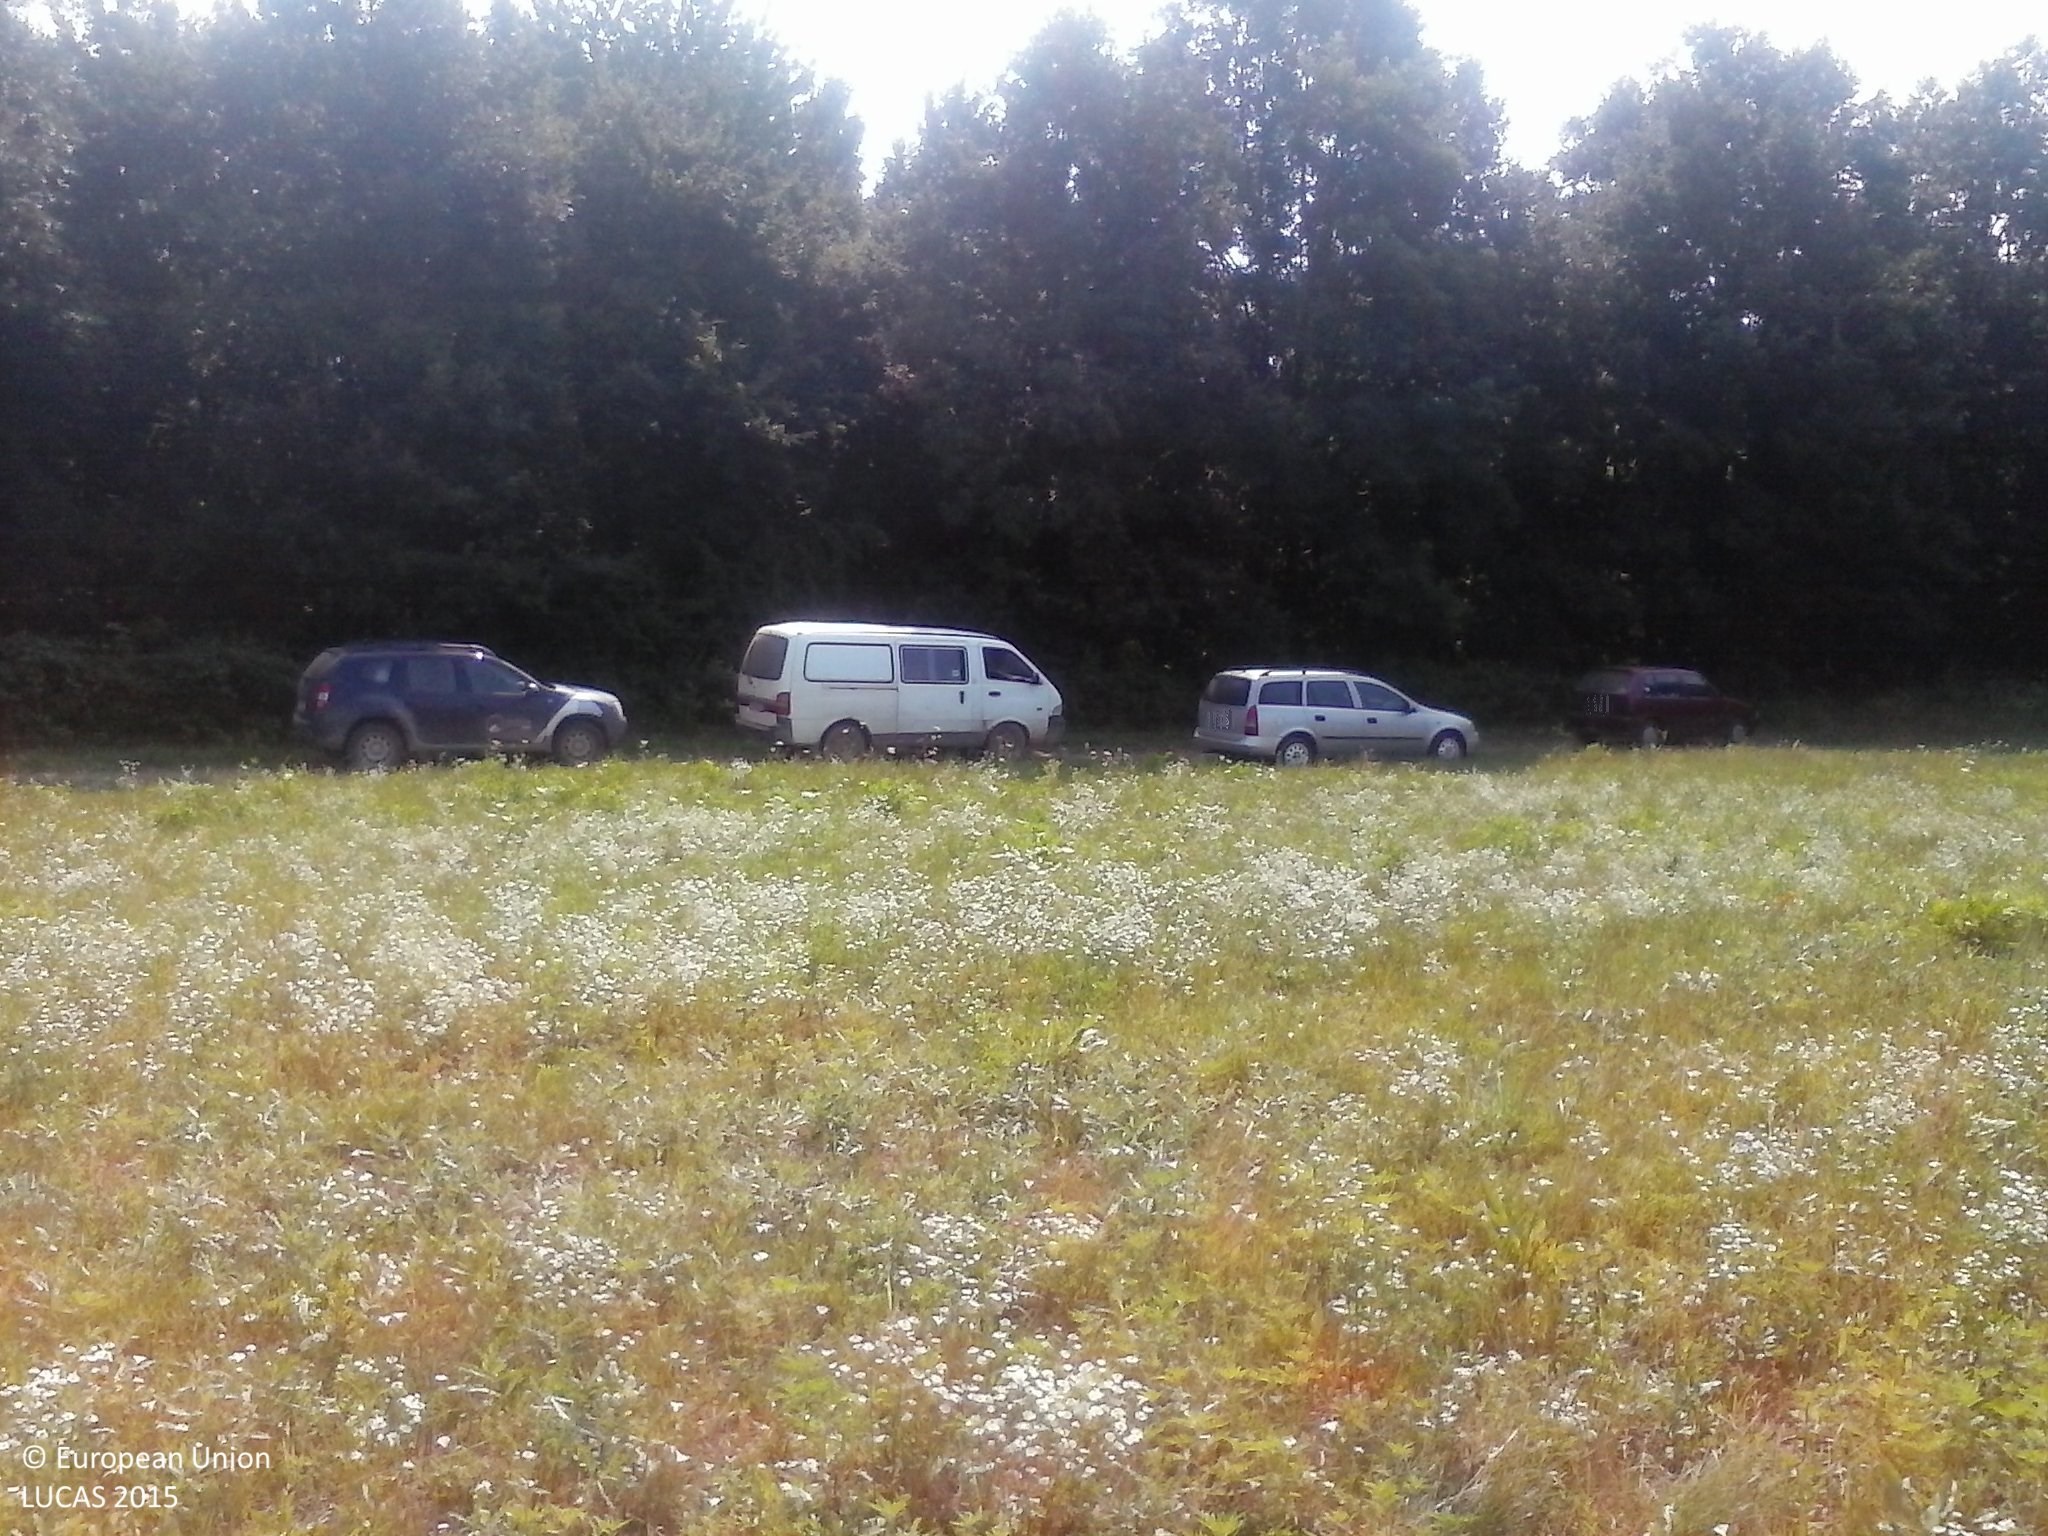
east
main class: Grassland
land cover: Spontaneously vegetated surfaces
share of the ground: > 75 %
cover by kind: herbaceous plants 100 %
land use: Fallow land
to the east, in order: Spontaneously vegetated surfaces; Tracks; Grass margins; Broadleaved woodland
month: August
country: HU
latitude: 46.1735
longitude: 17.8160
